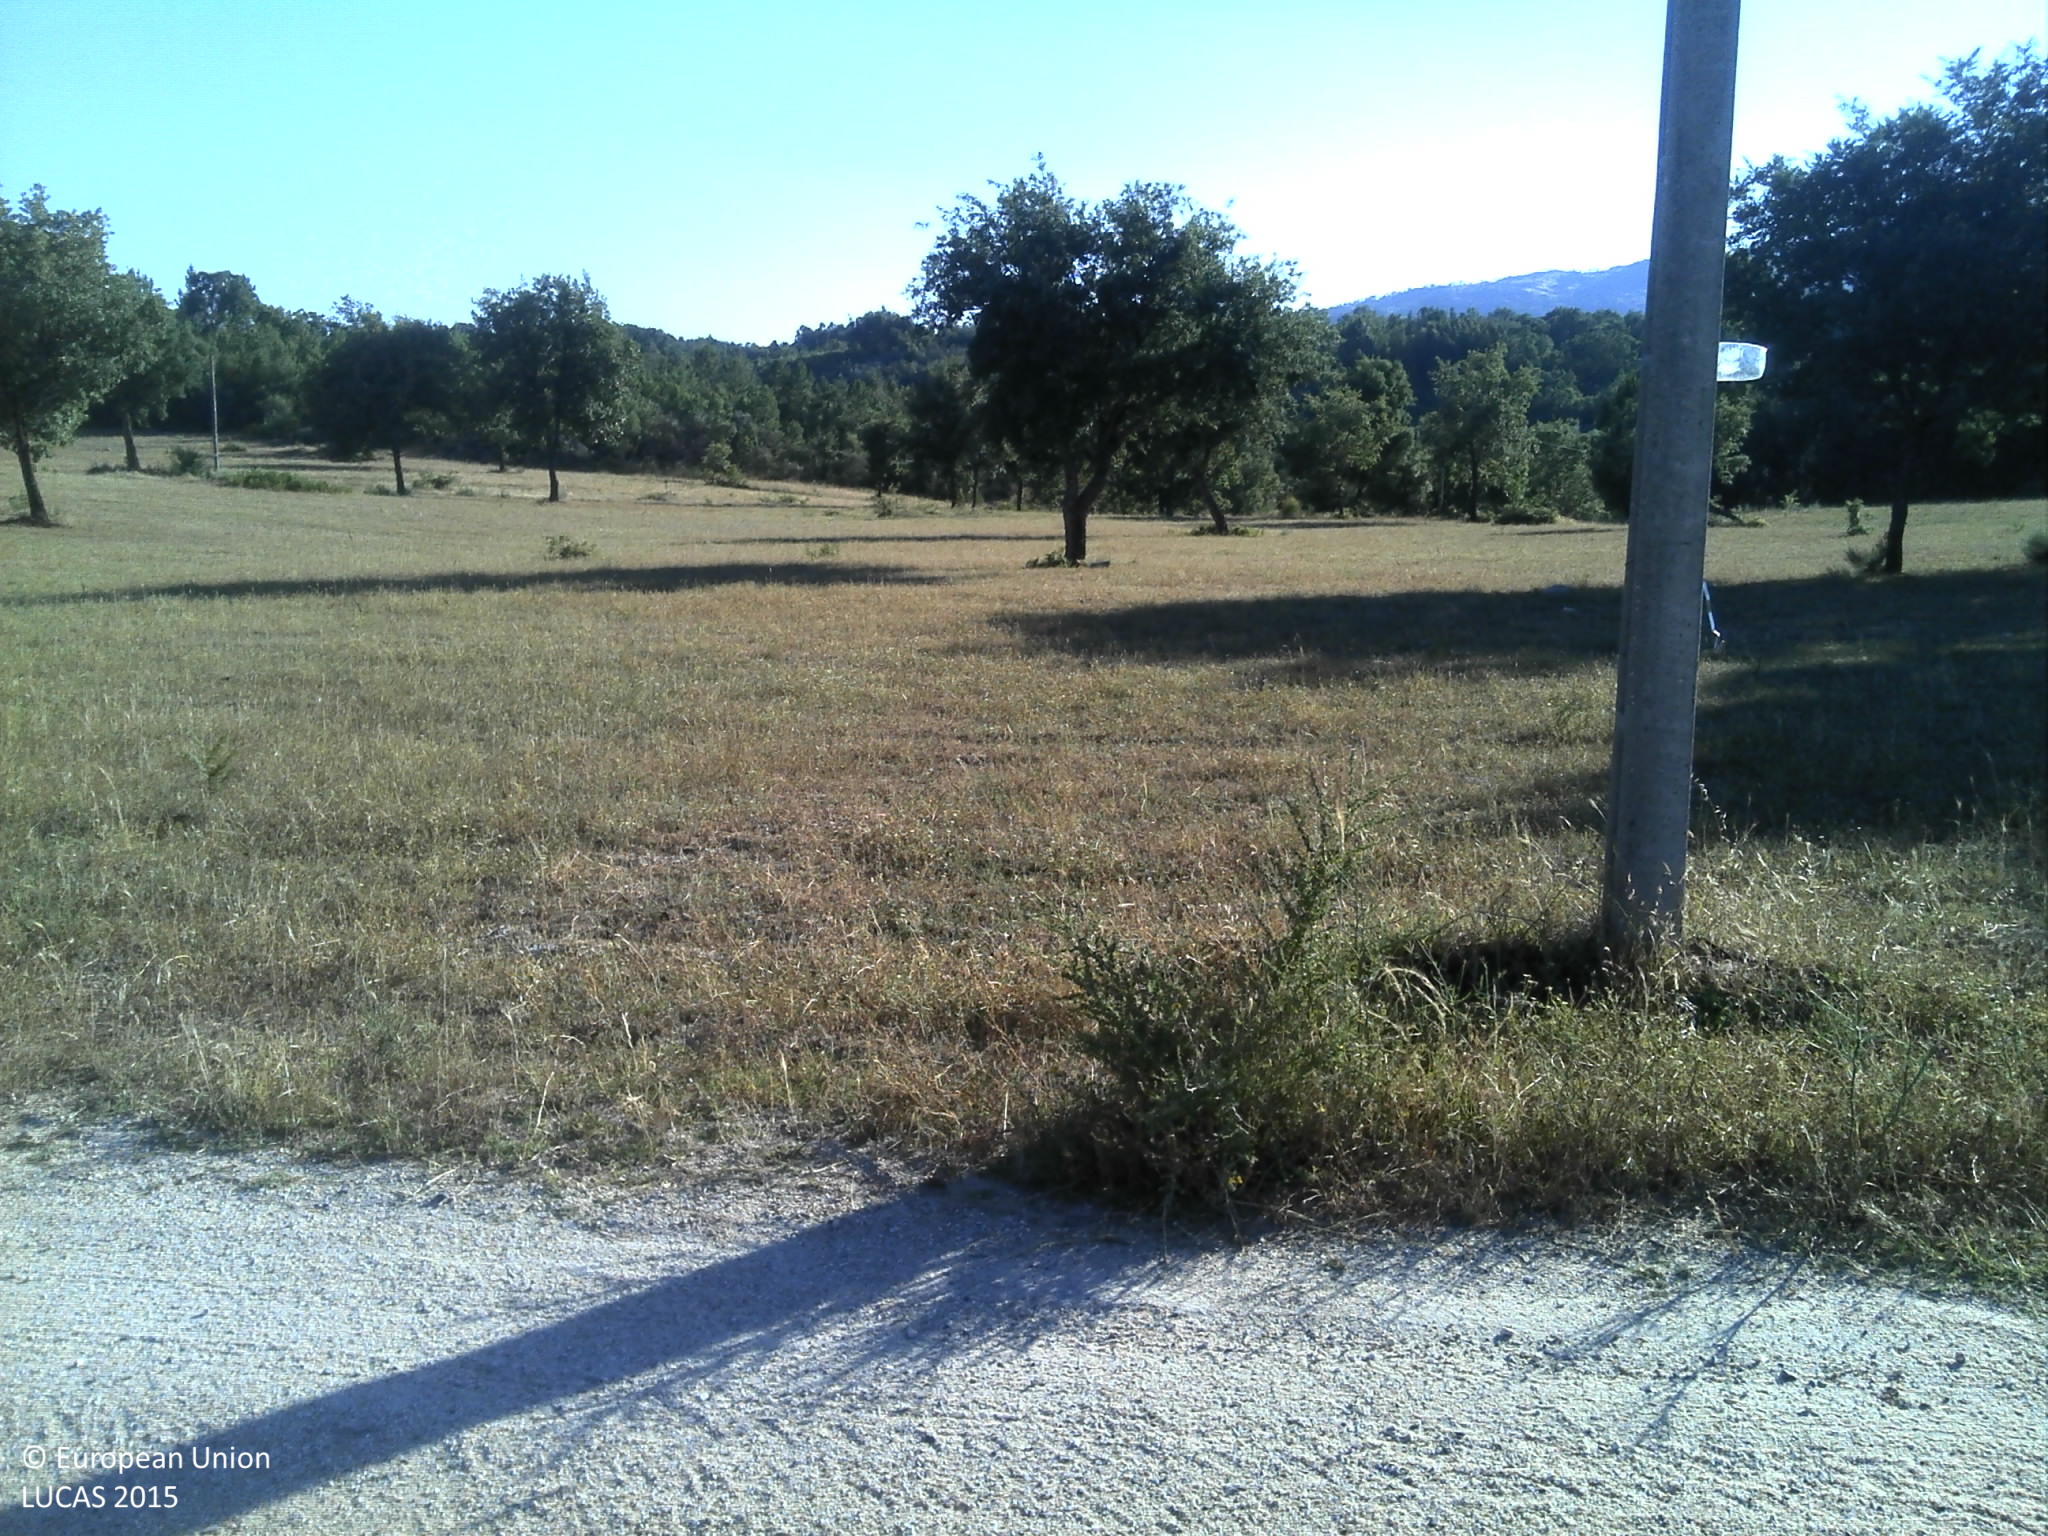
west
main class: Shrubland
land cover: Shrubland with sparse tree cover
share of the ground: 50 - 75 %
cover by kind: shrubs 65 %, unconsolidated bare surface 25 %, broadleaved forest trees 5 %, herbaceous plants 5 %
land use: Forestry
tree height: < 5 m
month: June
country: PT
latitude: 40.0749
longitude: -7.4452
